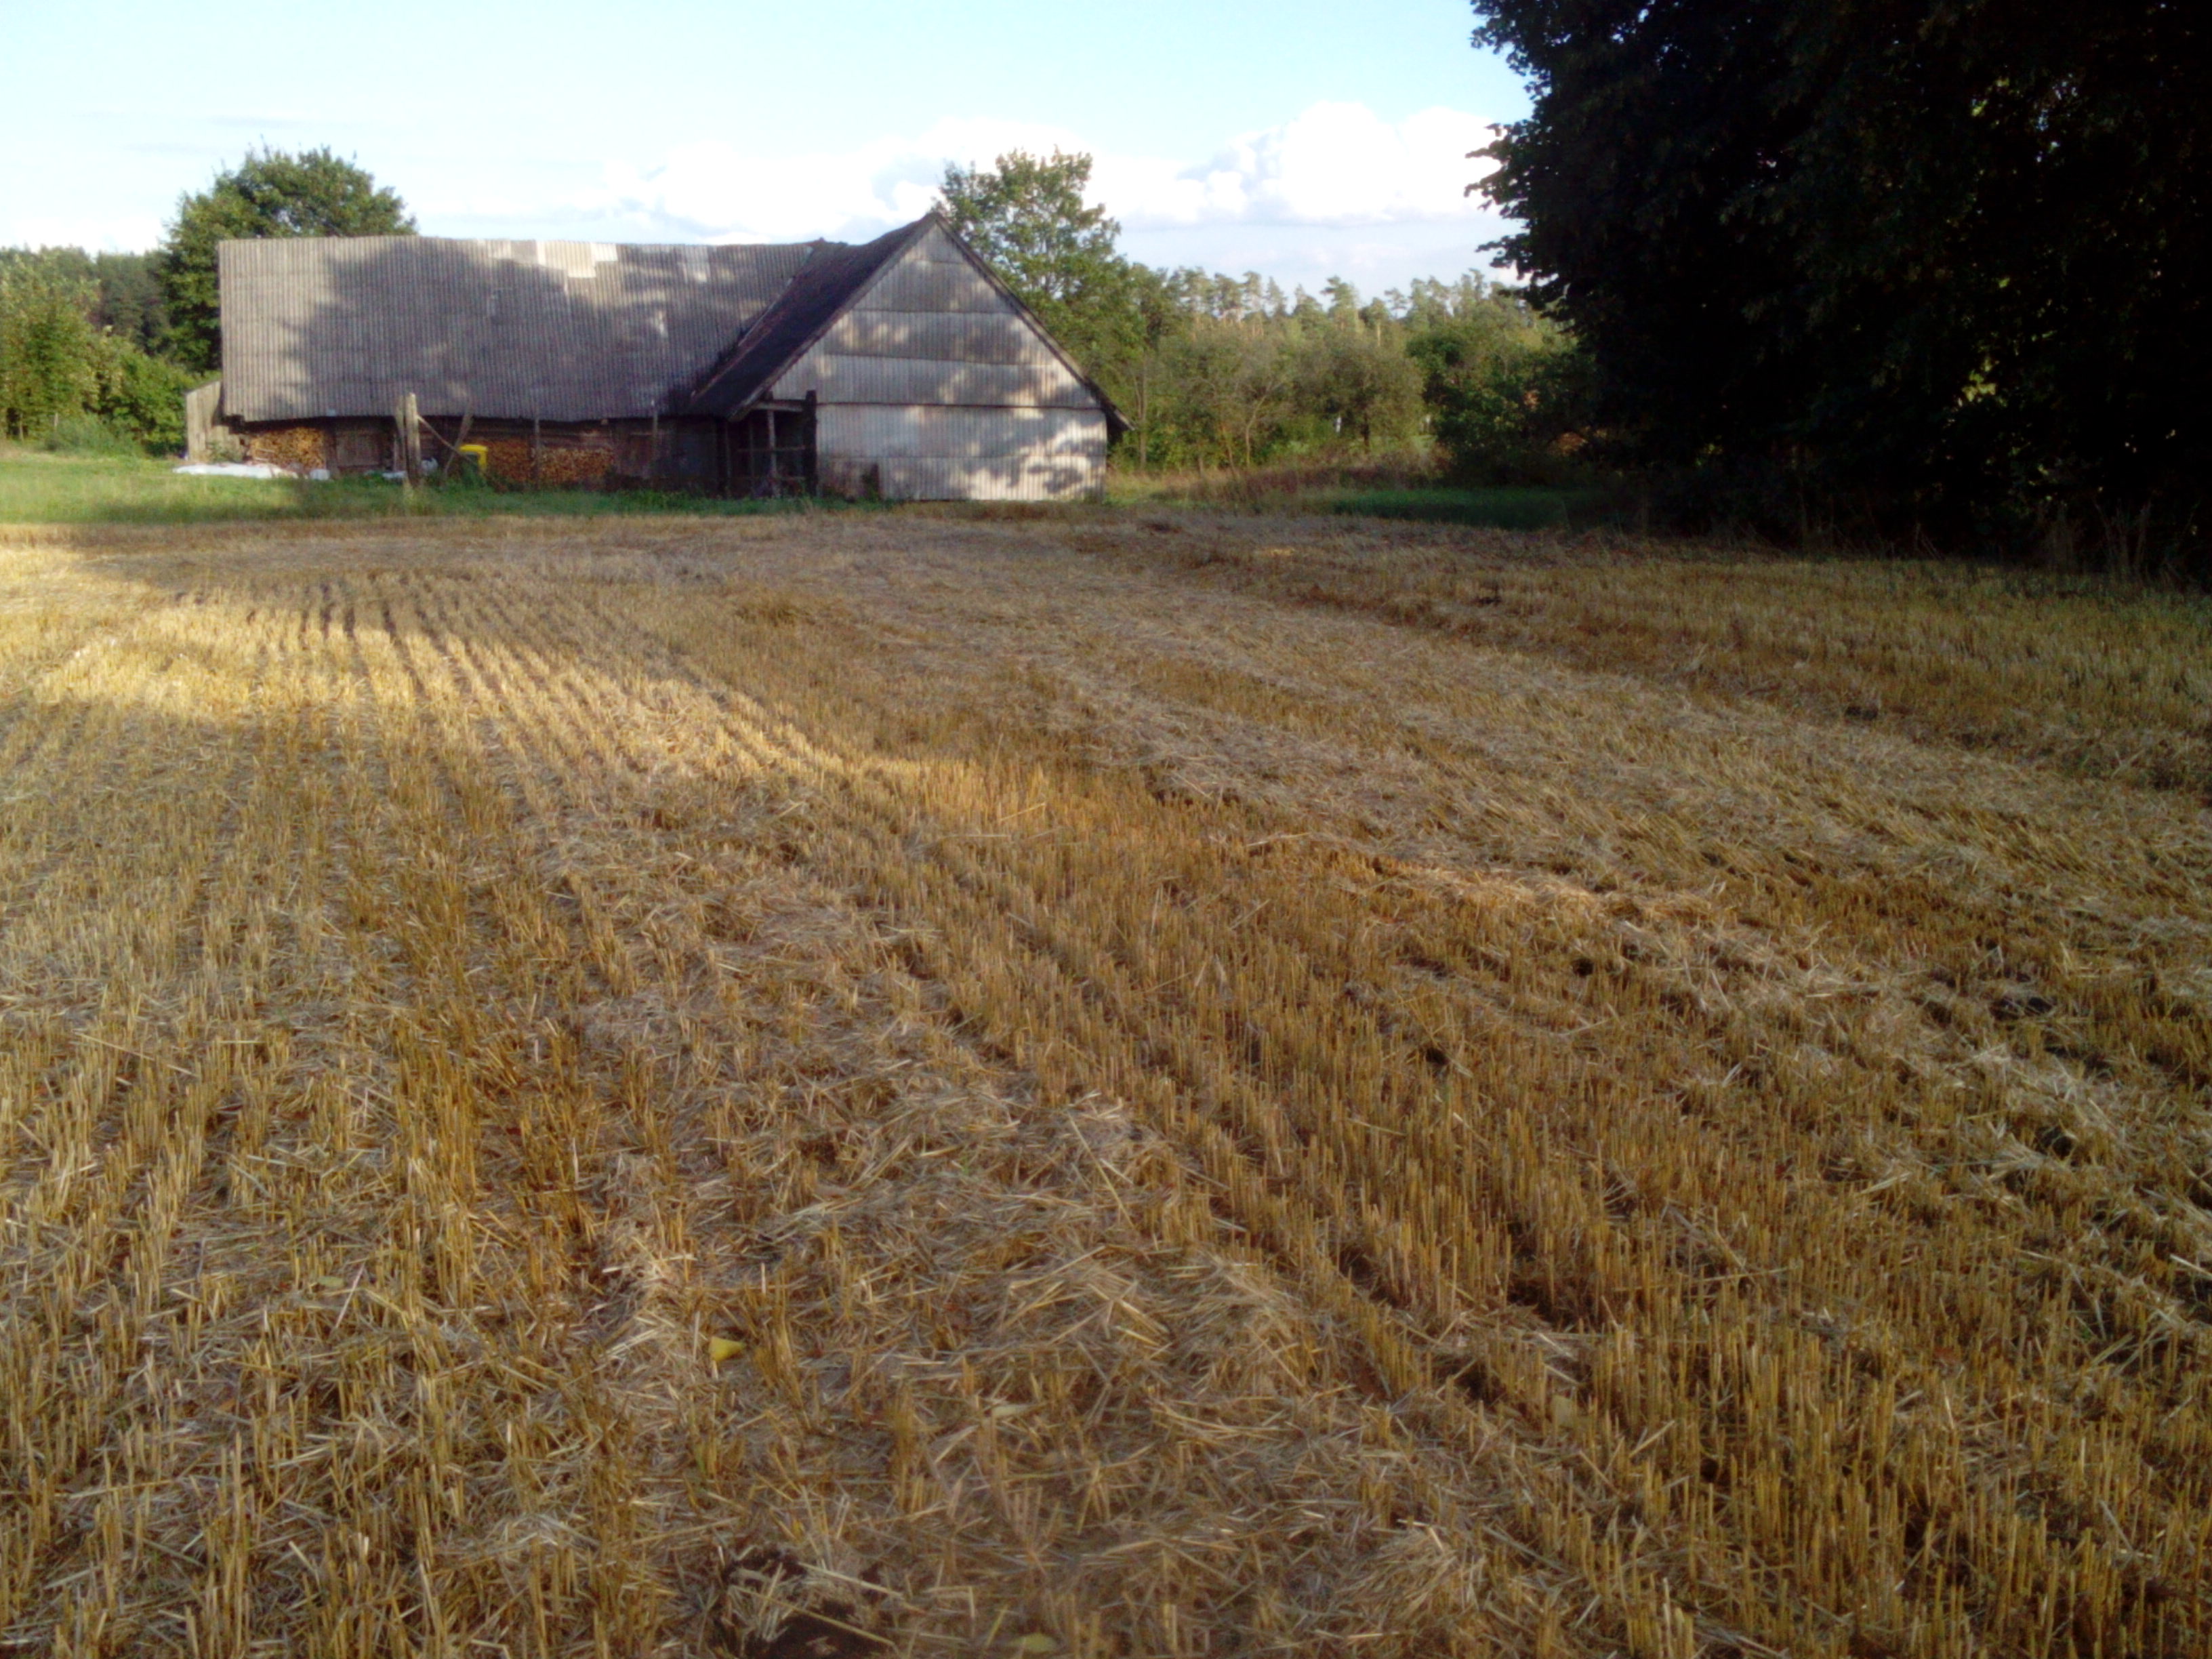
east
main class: Cropland
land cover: Common wheat
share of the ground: > 75 %
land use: Agriculture (excluding fallow land and kitchen gardens)
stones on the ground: < 10 %
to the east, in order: Common wheat; Electric lines; Grass margins; Paved roads, cycling and walking lanes; Grassland without tree/shrub cover; Artificial constructions in urban areas; Apple fruit; Grassland with sparse tree/shrub cover; Rape and turnip rape
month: September
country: LT
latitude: 55.9001
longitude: 22.8768
